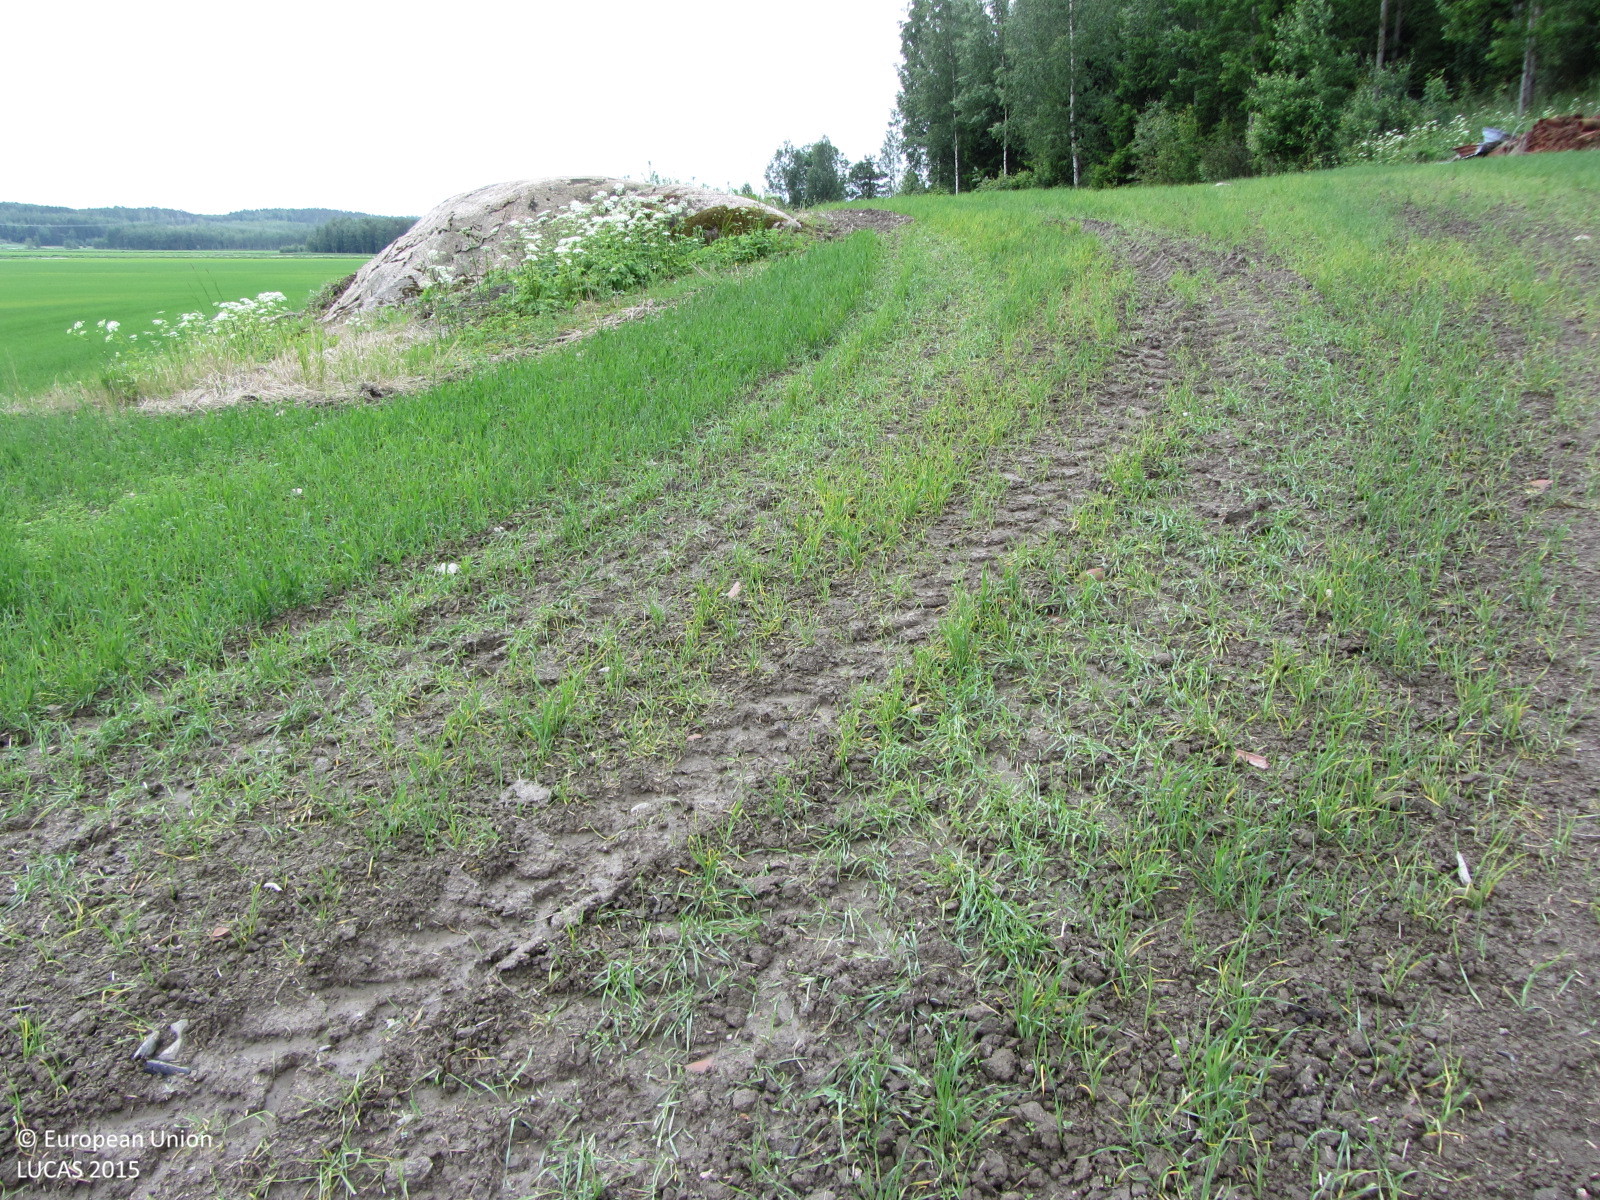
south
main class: Cropland
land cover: Common wheat
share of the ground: > 75 %
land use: Agriculture (excluding fallow land and kitchen gardens)
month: June
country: FI
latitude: 60.2501
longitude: 23.2179
